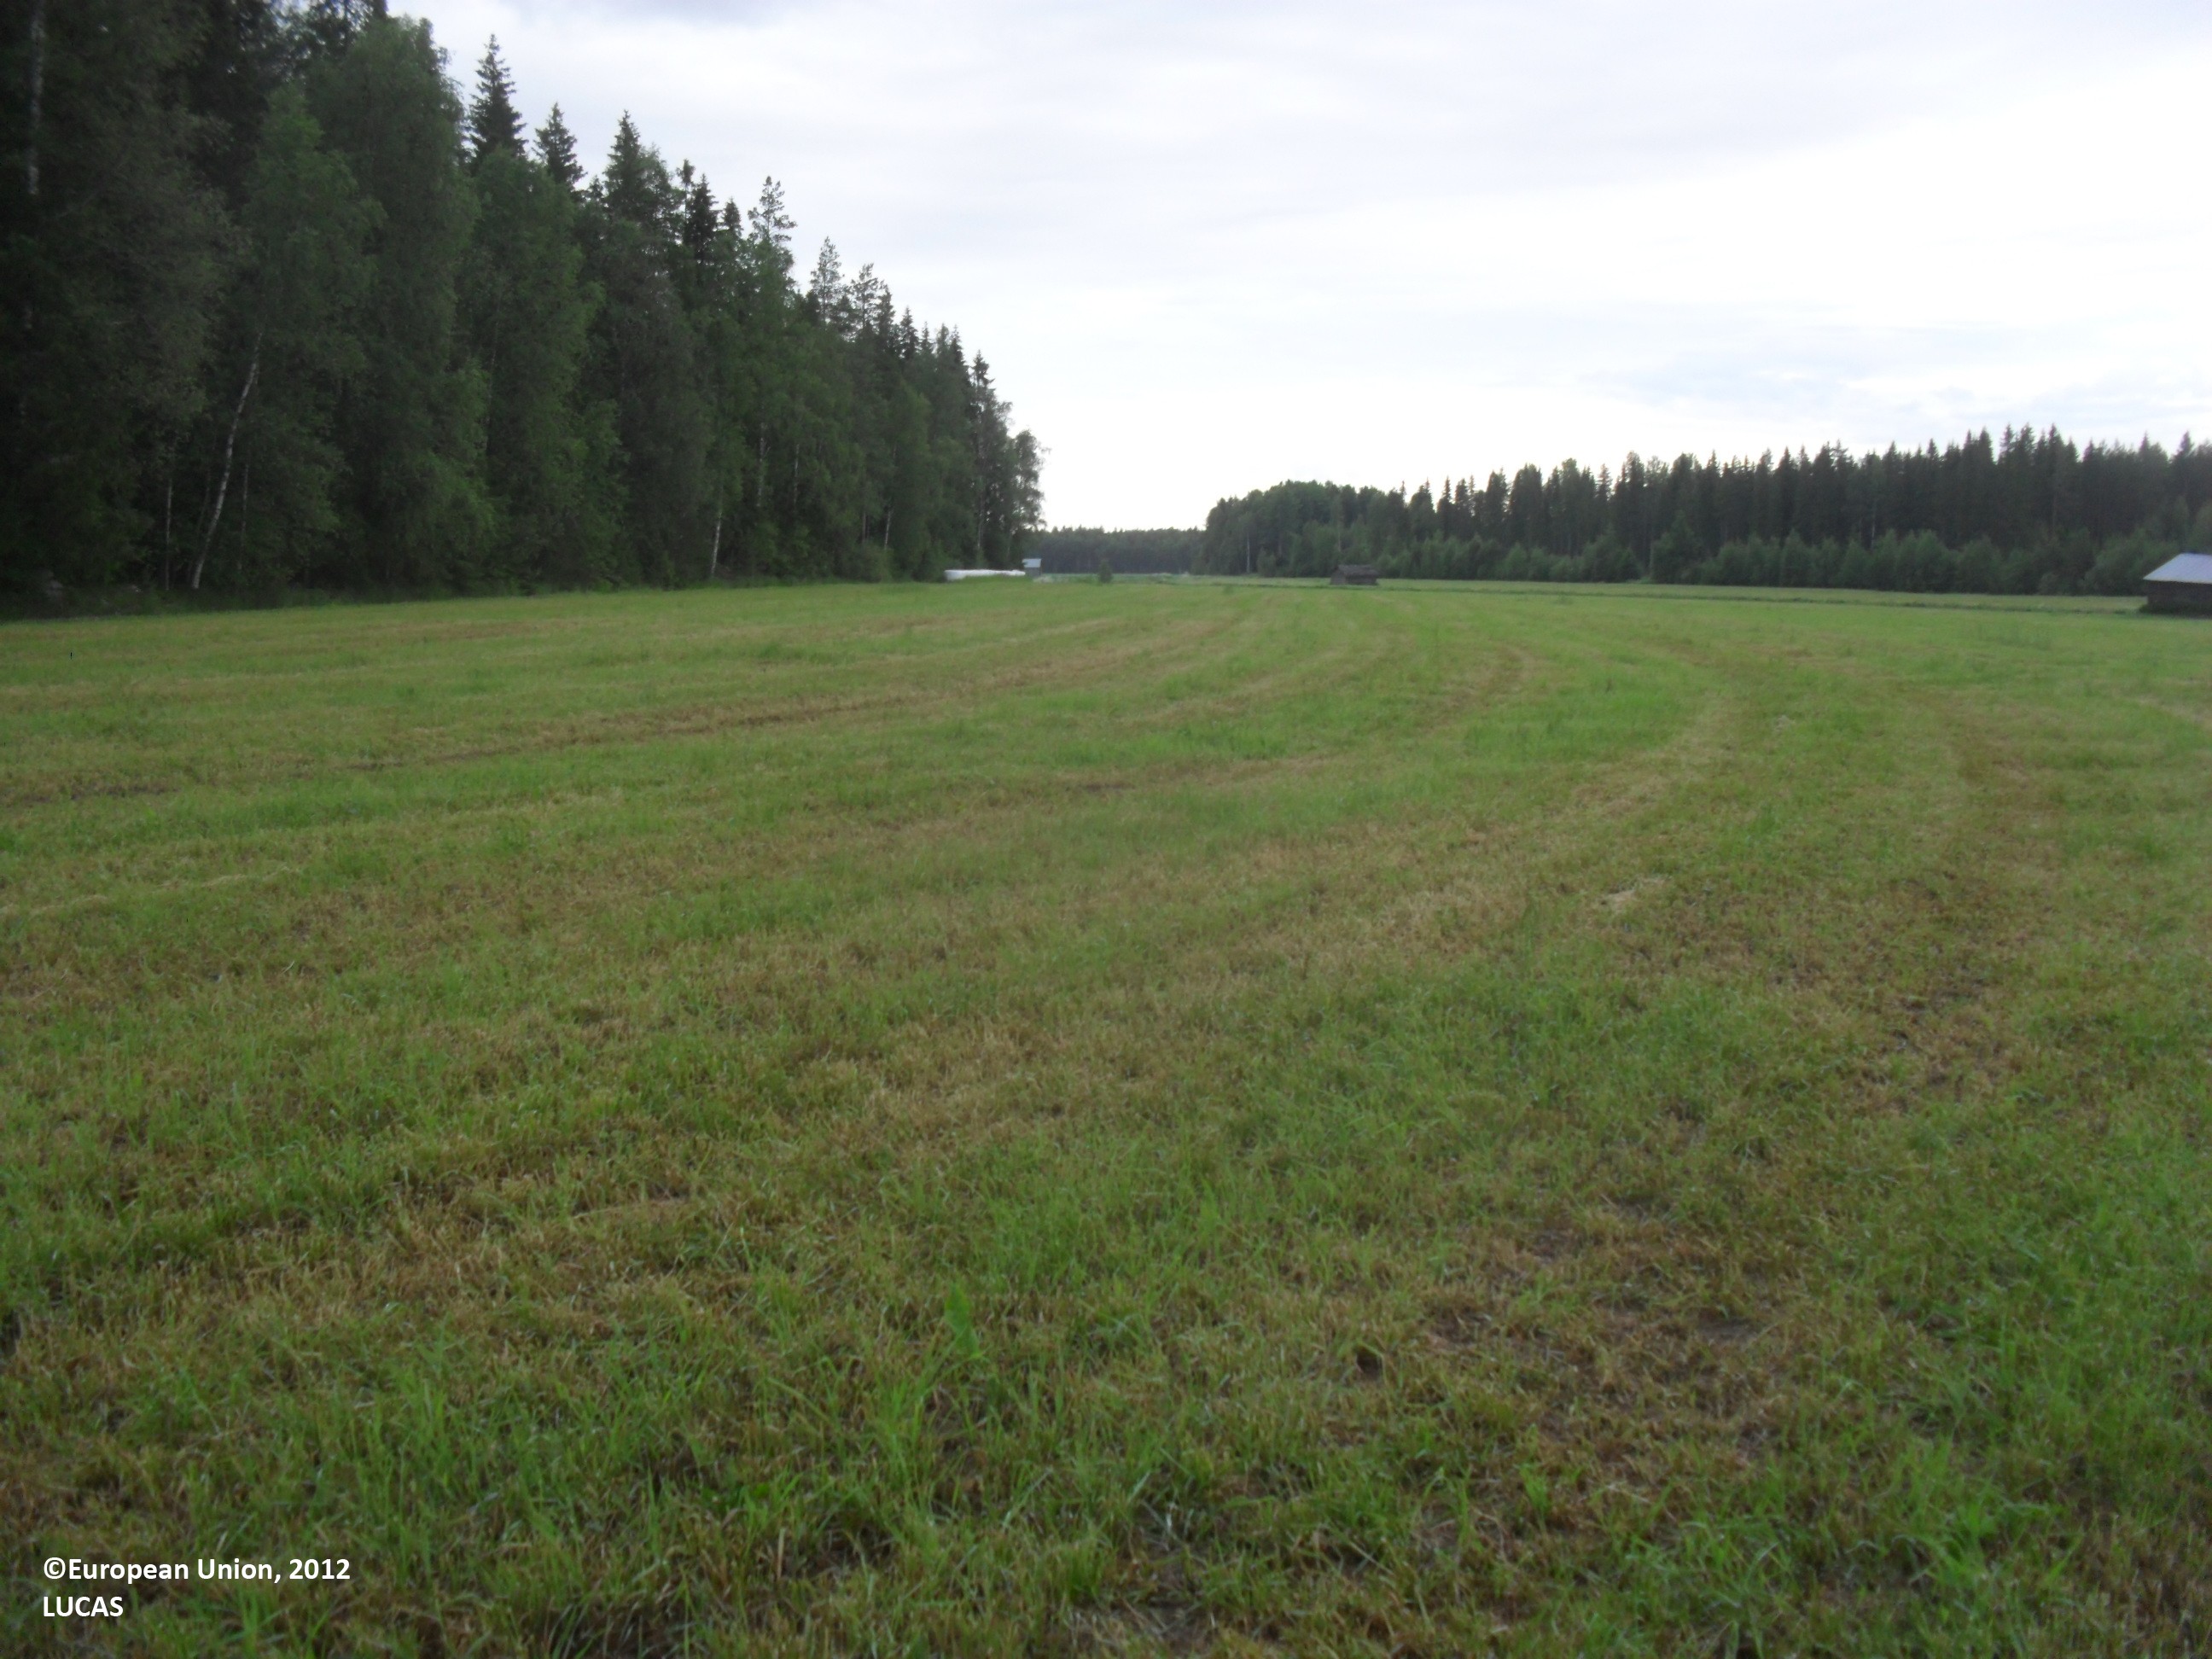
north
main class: Cropland
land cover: Temporary grasslands
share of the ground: > 75 %
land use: Agriculture (excluding fallow land and kitchen gardens)
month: June
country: FI
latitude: 63.3460
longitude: 23.2261
